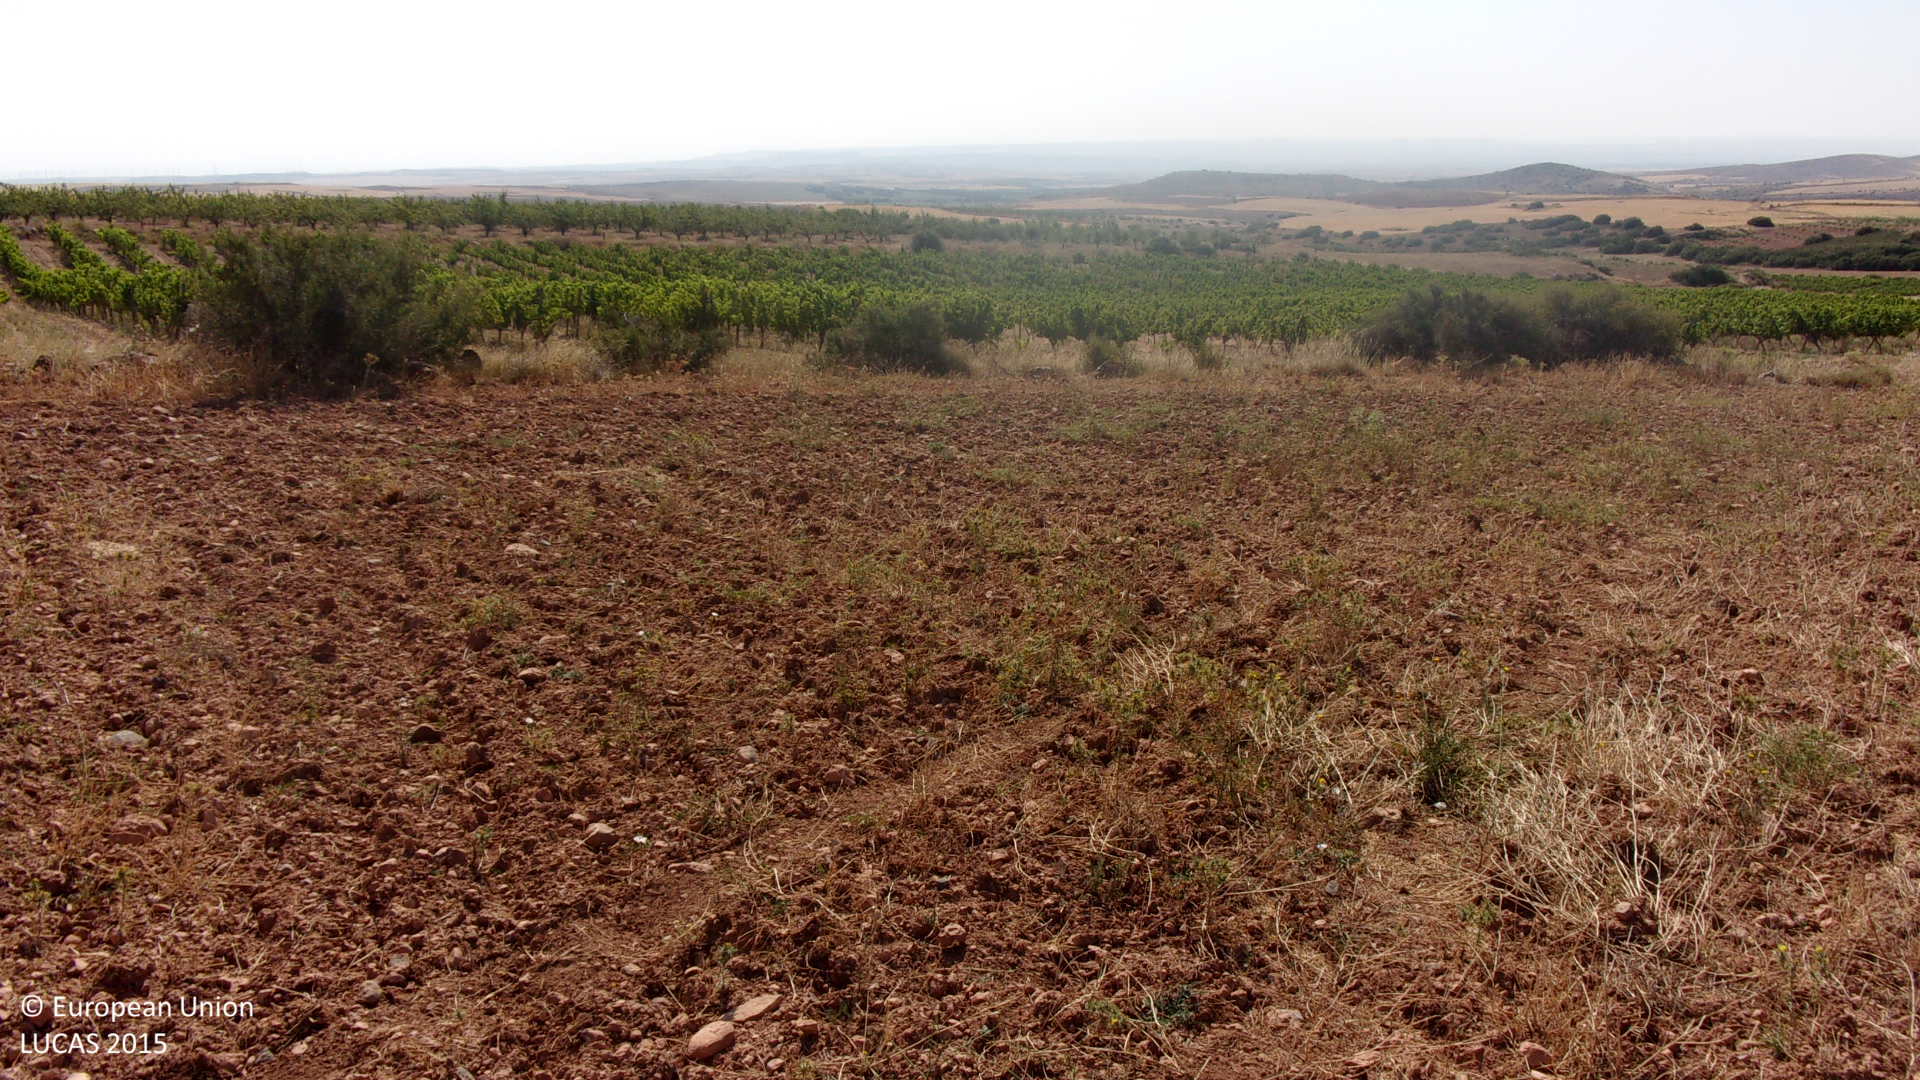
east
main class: Grassland
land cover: Spontaneously vegetated surfaces
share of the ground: 25 - 50 %
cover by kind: unconsolidated bare surface 65 %, herbaceous plants 35 %
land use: Fallow land
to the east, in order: Spontaneously vegetated surfaces; Shruby margins; Tracks; Vineyards; Grass margins; Nuts trees
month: July
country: ES
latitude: 41.6744
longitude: -1.4499
